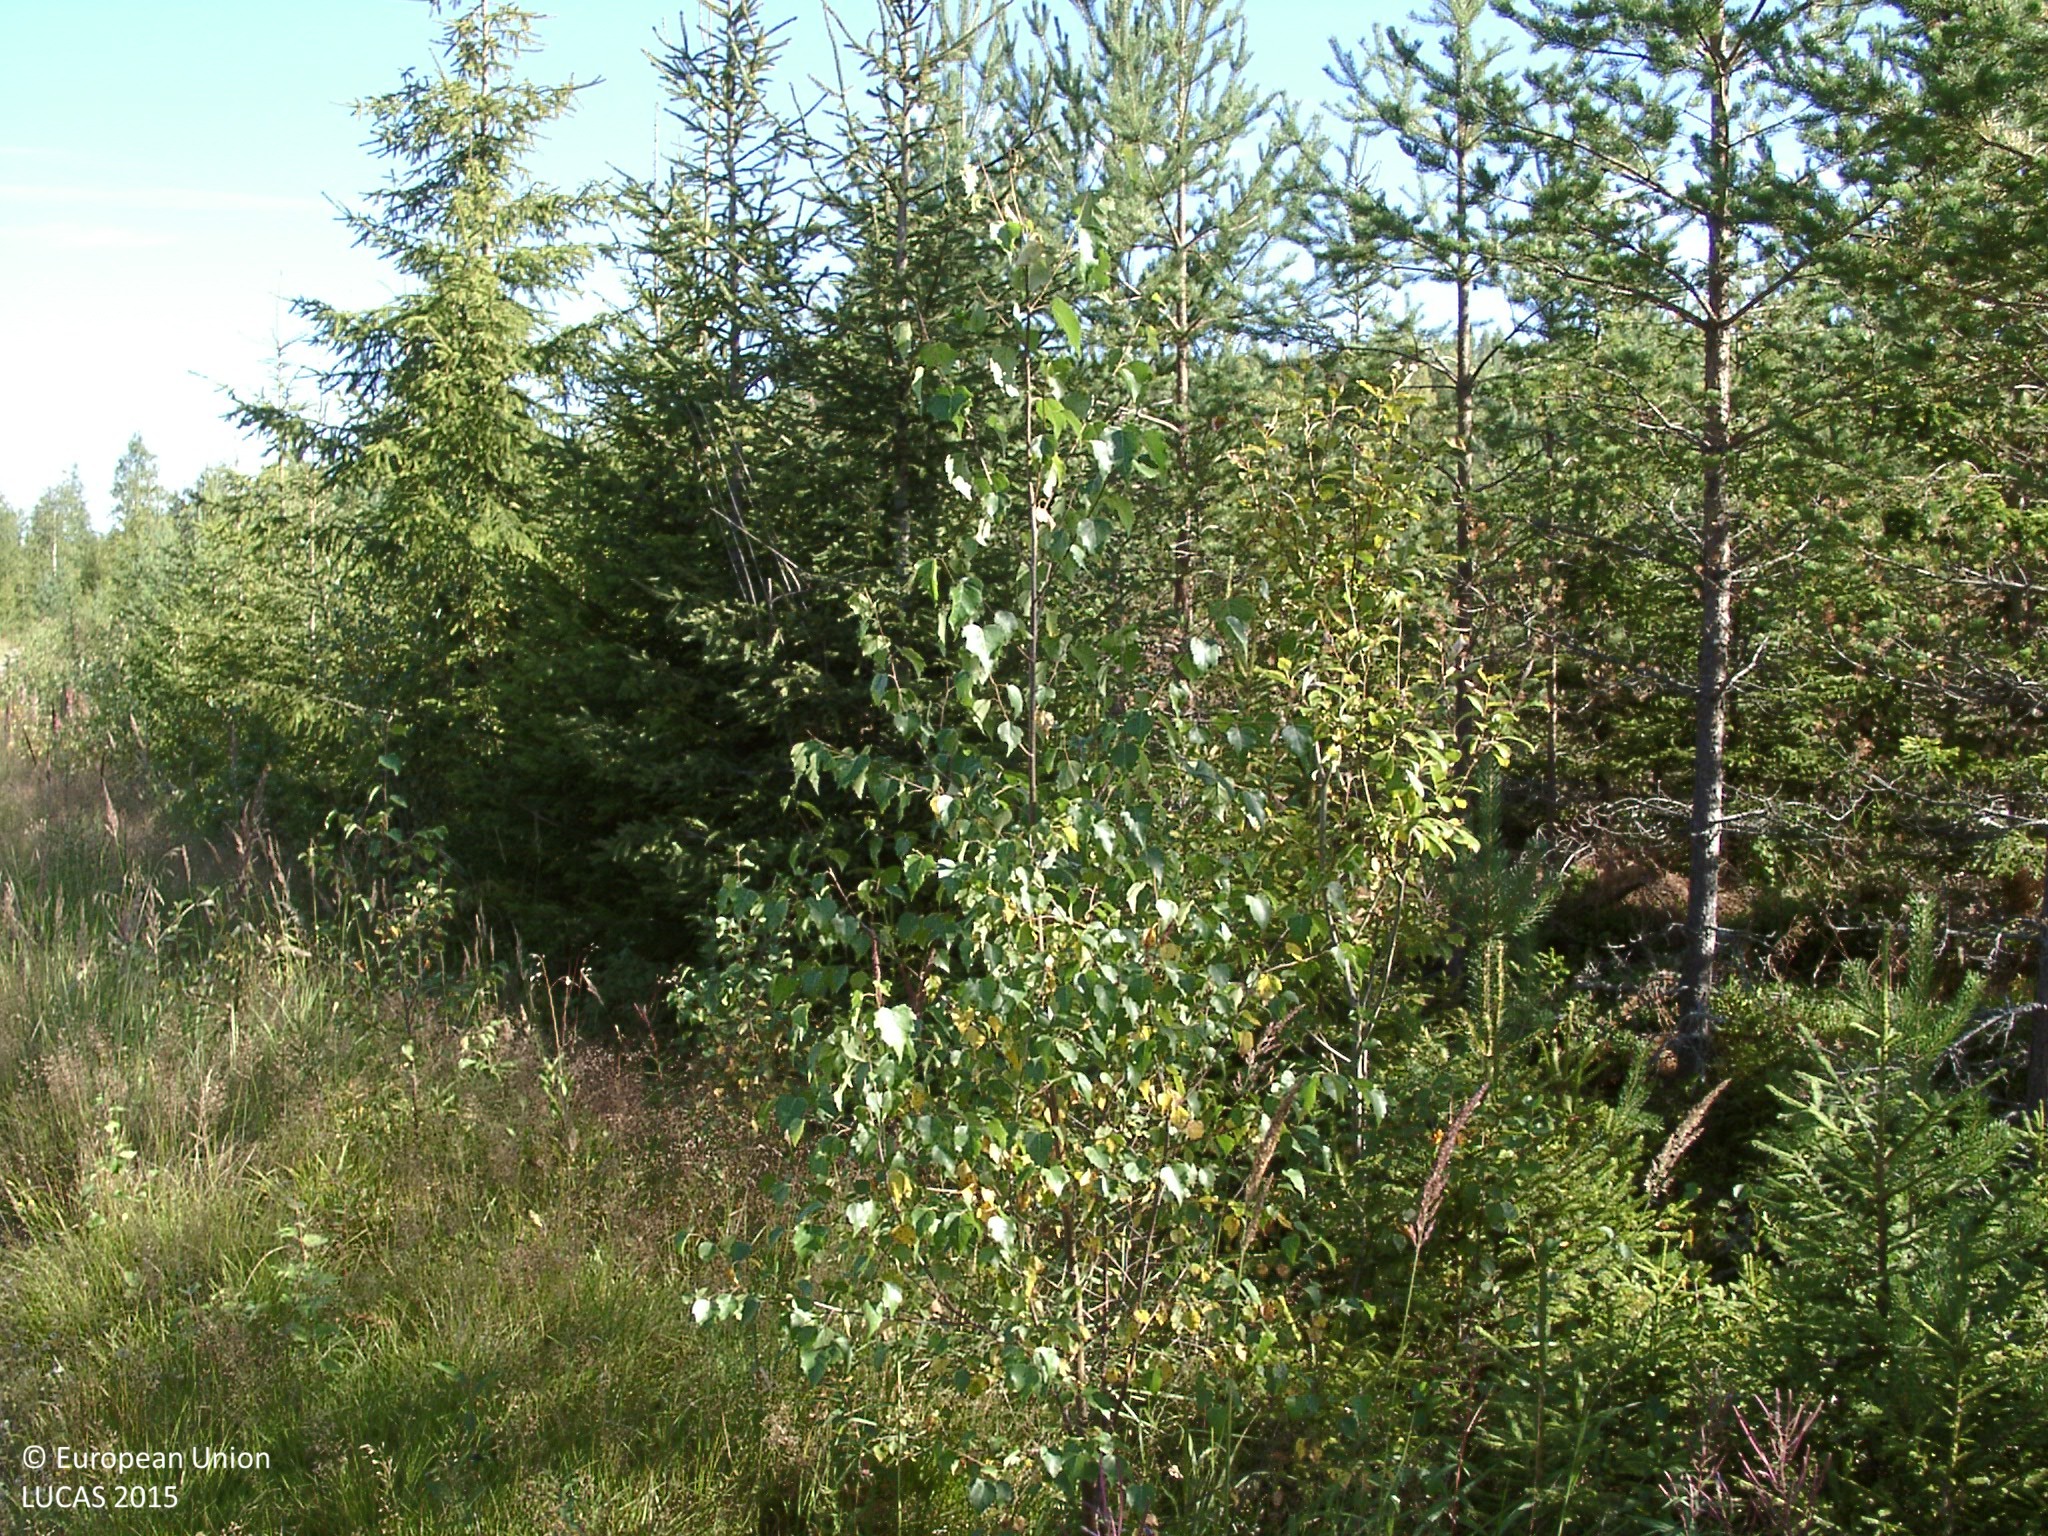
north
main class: Woodland
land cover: Other coniferous woodland
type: boreal forest
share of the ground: 50 - 75 %
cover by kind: coniferous forest trees 65 %, shrubs 10 %, herbaceous plants 5 %, lichens and mosses 5 %
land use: Forestry
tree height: < 5 m
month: August
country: FI
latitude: 61.8949
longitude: 24.9663
